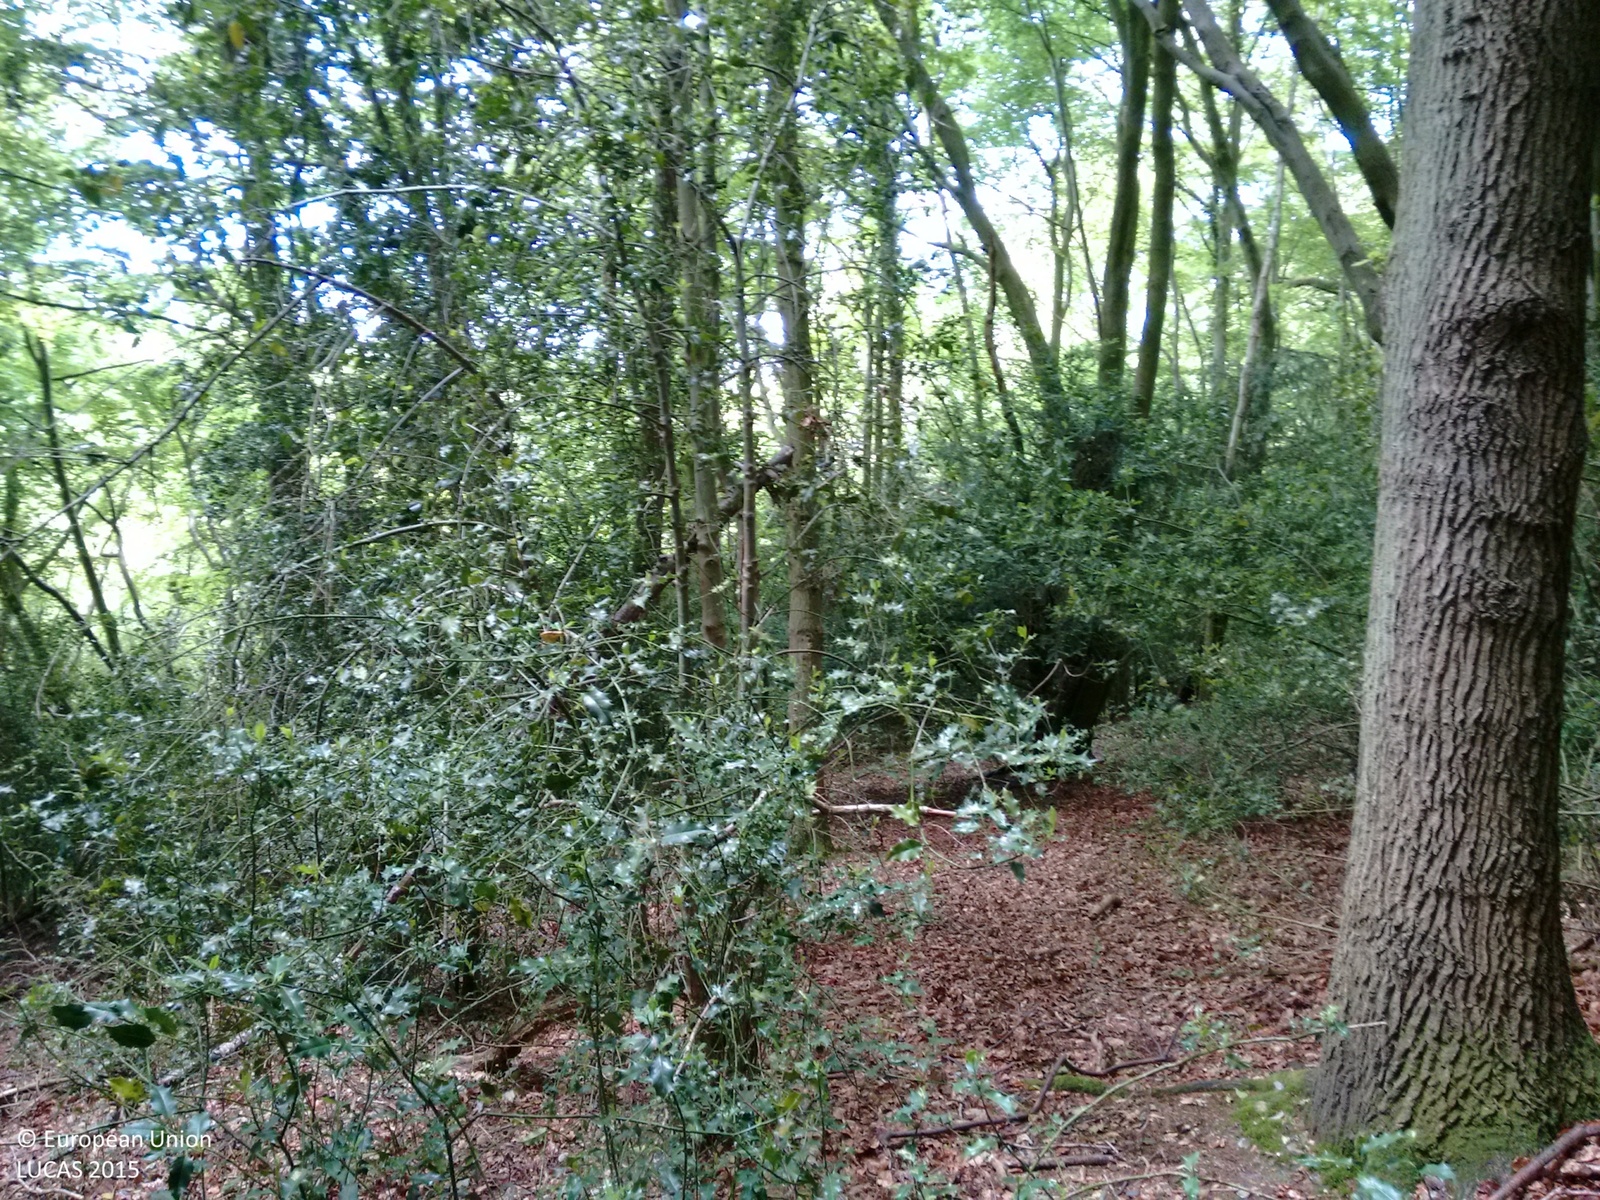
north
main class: Woodland
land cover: Broadleaved woodland
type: mesophytic deciduous forest
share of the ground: > 75 %
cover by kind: broadleaved forest trees 95 %, shrubs 5 %
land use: Semi-natural and natural areas not in use
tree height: > 5 m
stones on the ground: 25 - 50 %
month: June
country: GB
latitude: 51.6873
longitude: -0.7601
